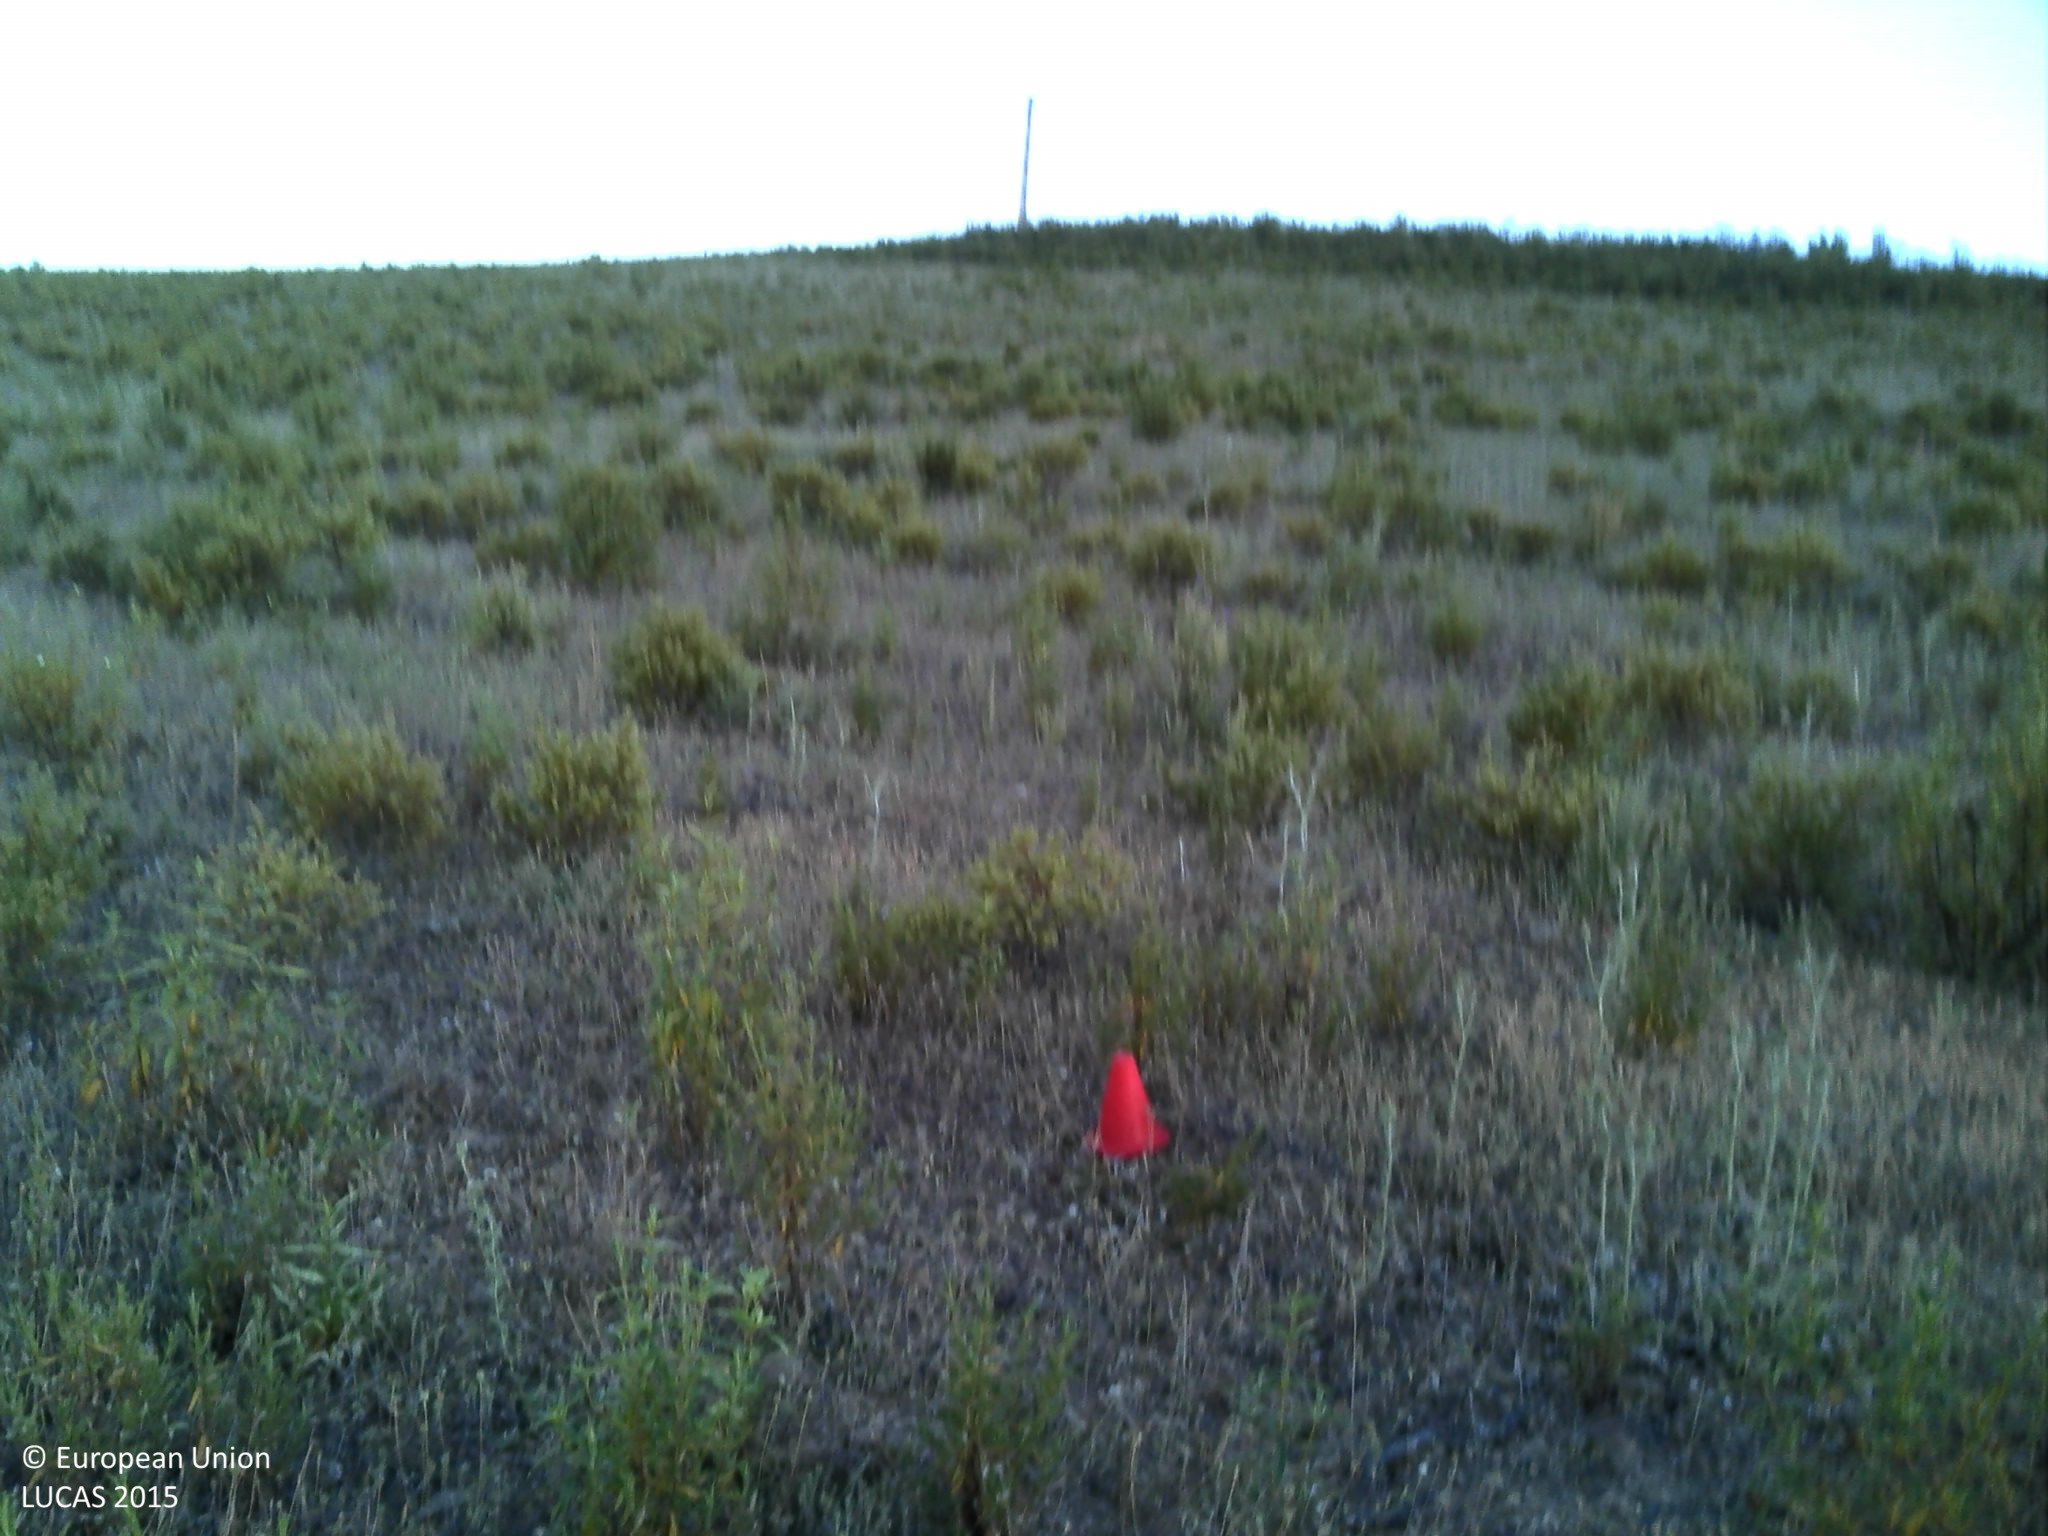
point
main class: Shrubland
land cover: Shrubland without tree cover
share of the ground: 10 - 25 %
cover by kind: herbaceous plants 65 %, shrubs 25 %, unconsolidated bare surface 10 %
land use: Abandoned areas
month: May
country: PT
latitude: 37.4356
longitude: -7.5379
